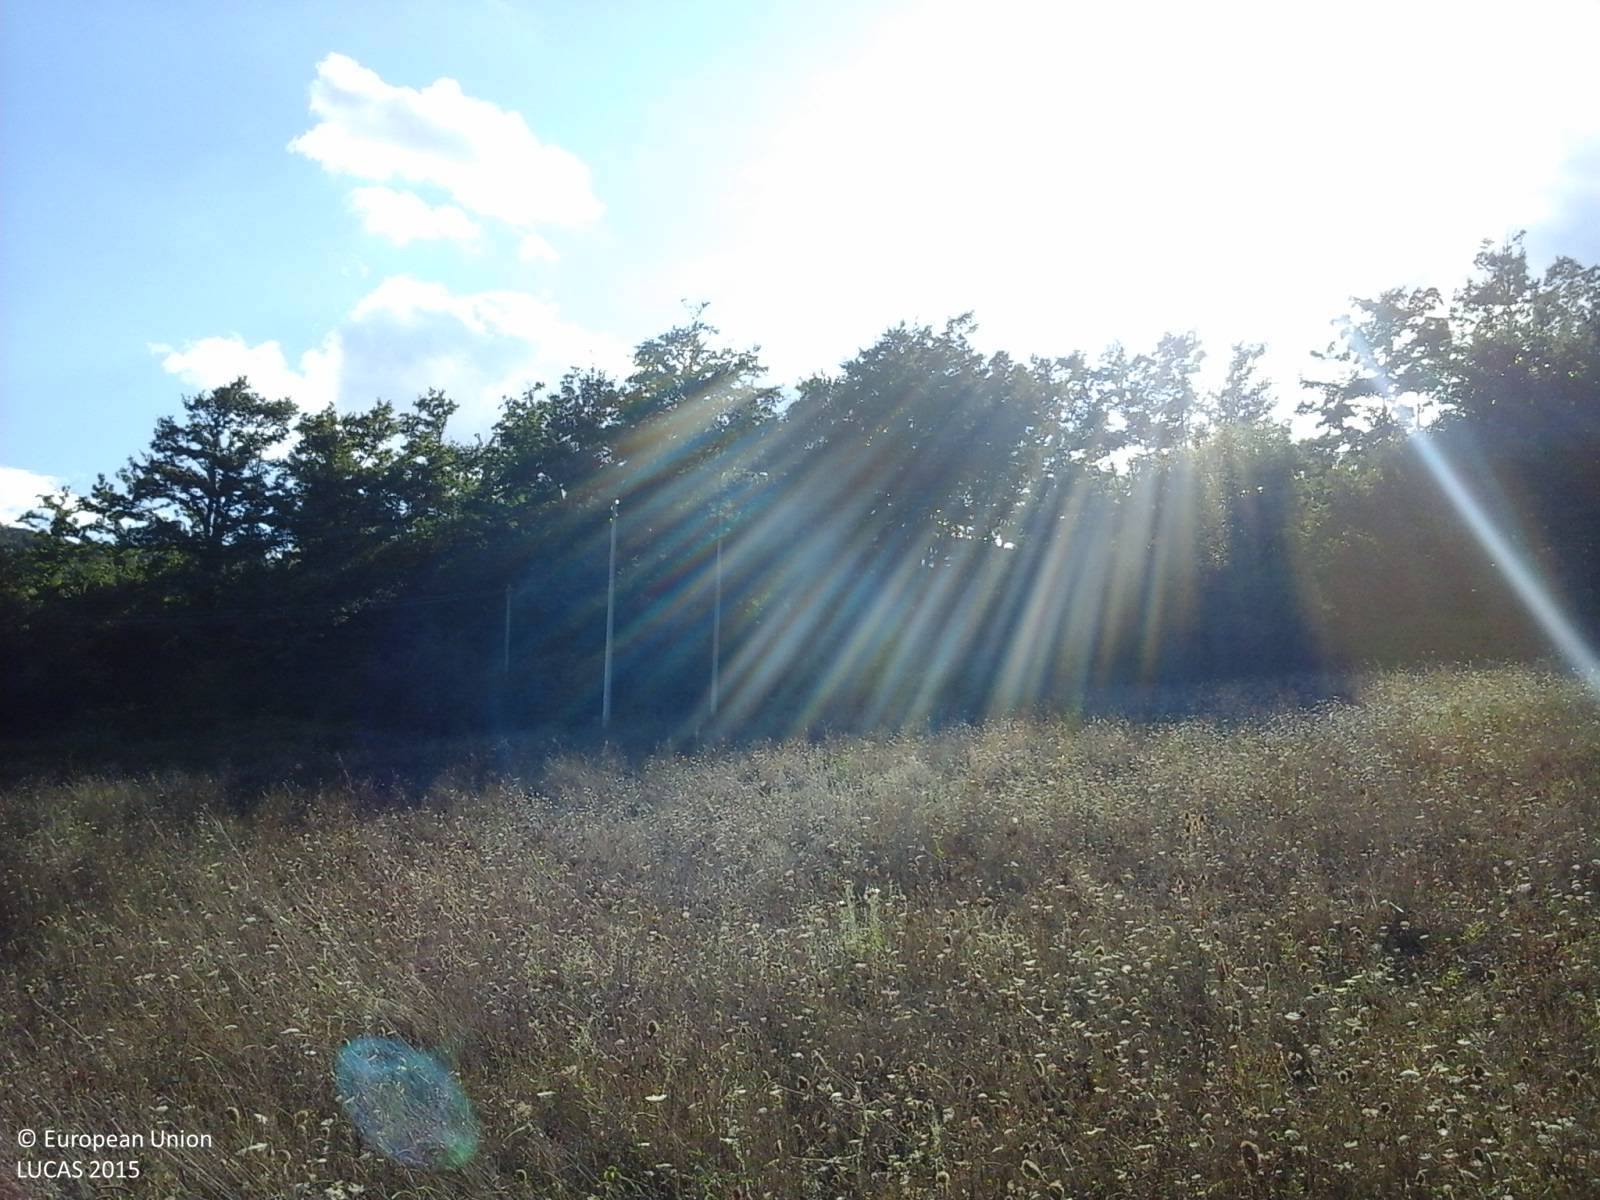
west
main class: Grassland
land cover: Grassland without tree/shrub cover
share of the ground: > 75 %
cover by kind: herbaceous plants 100 %
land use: Agriculture (excluding fallow land and kitchen gardens)
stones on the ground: < 10 %
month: August
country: IT
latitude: 43.3005
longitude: 12.1020
